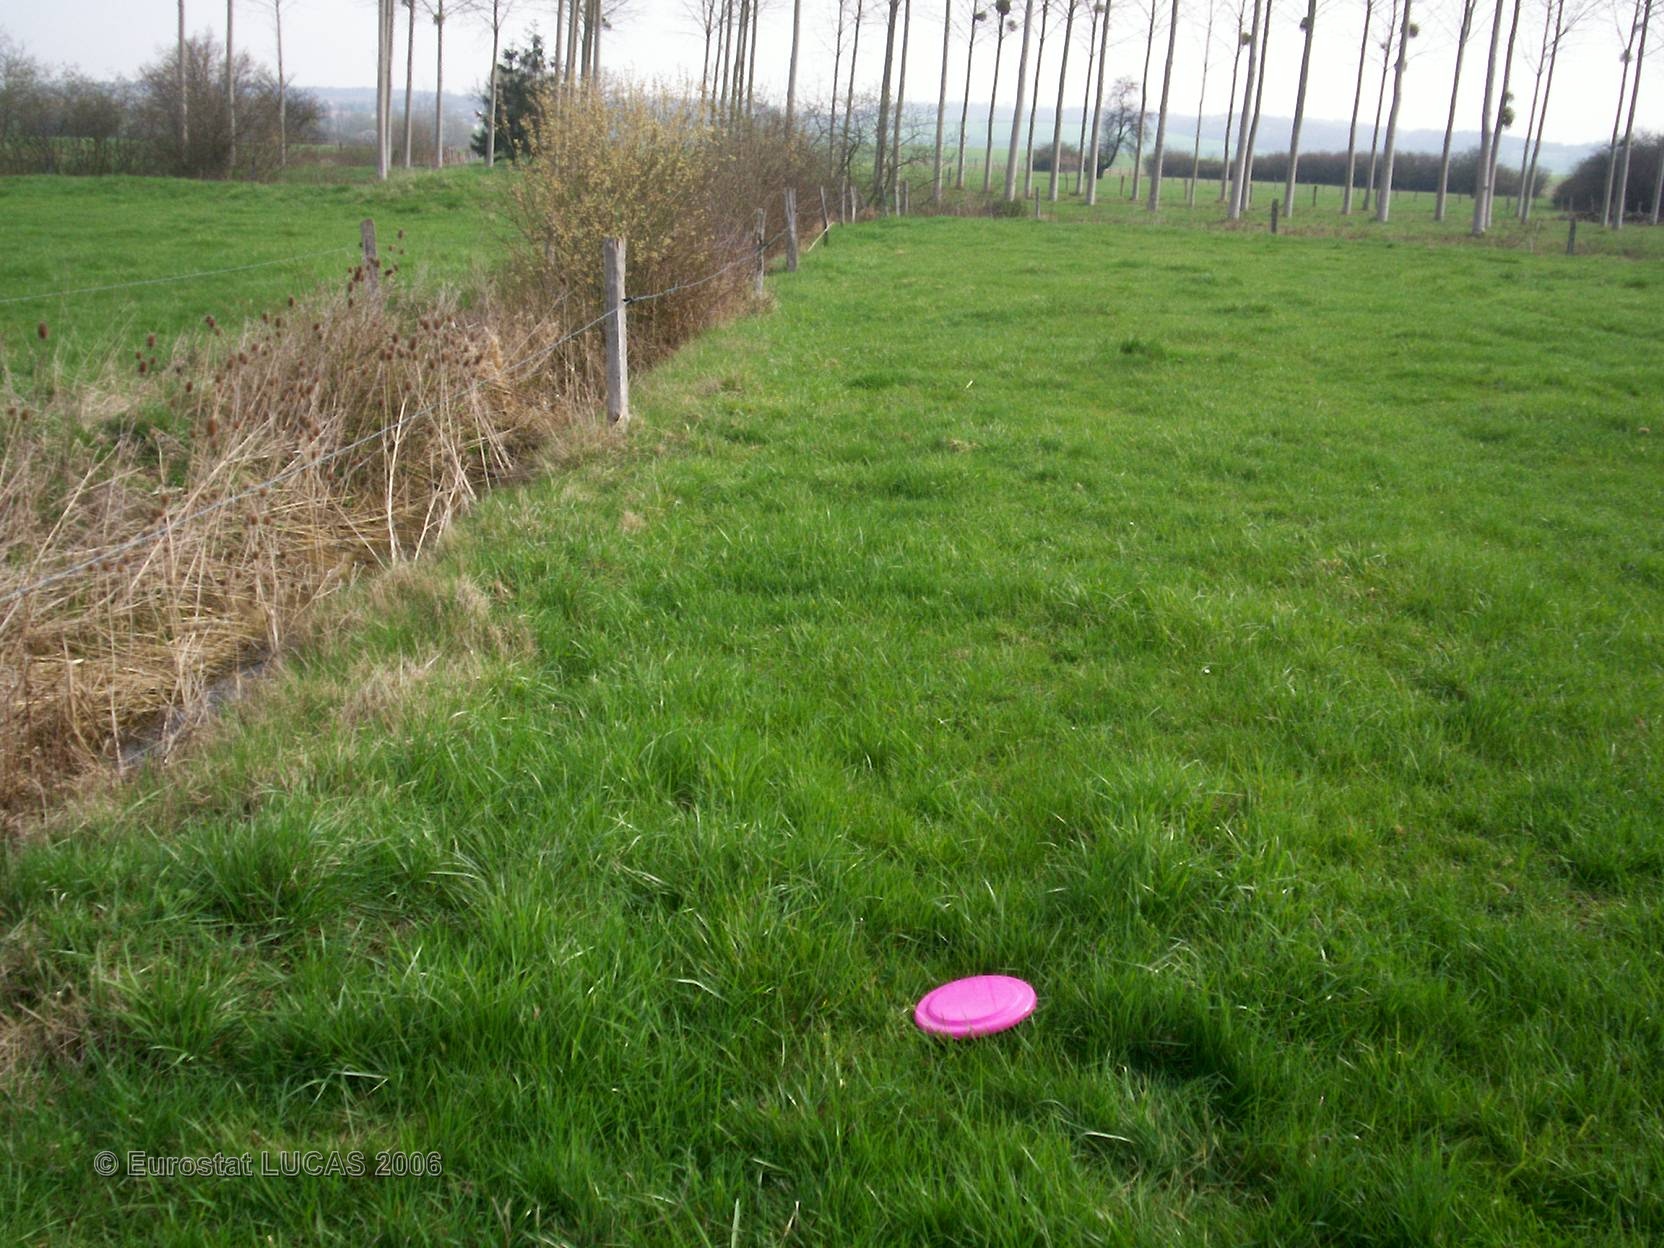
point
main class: Grassland
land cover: Grassland without tree/shrub cover
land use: Agriculture (excluding fallow land and kitchen gardens)
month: April
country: FR
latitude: 48.8139
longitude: 5.9005
